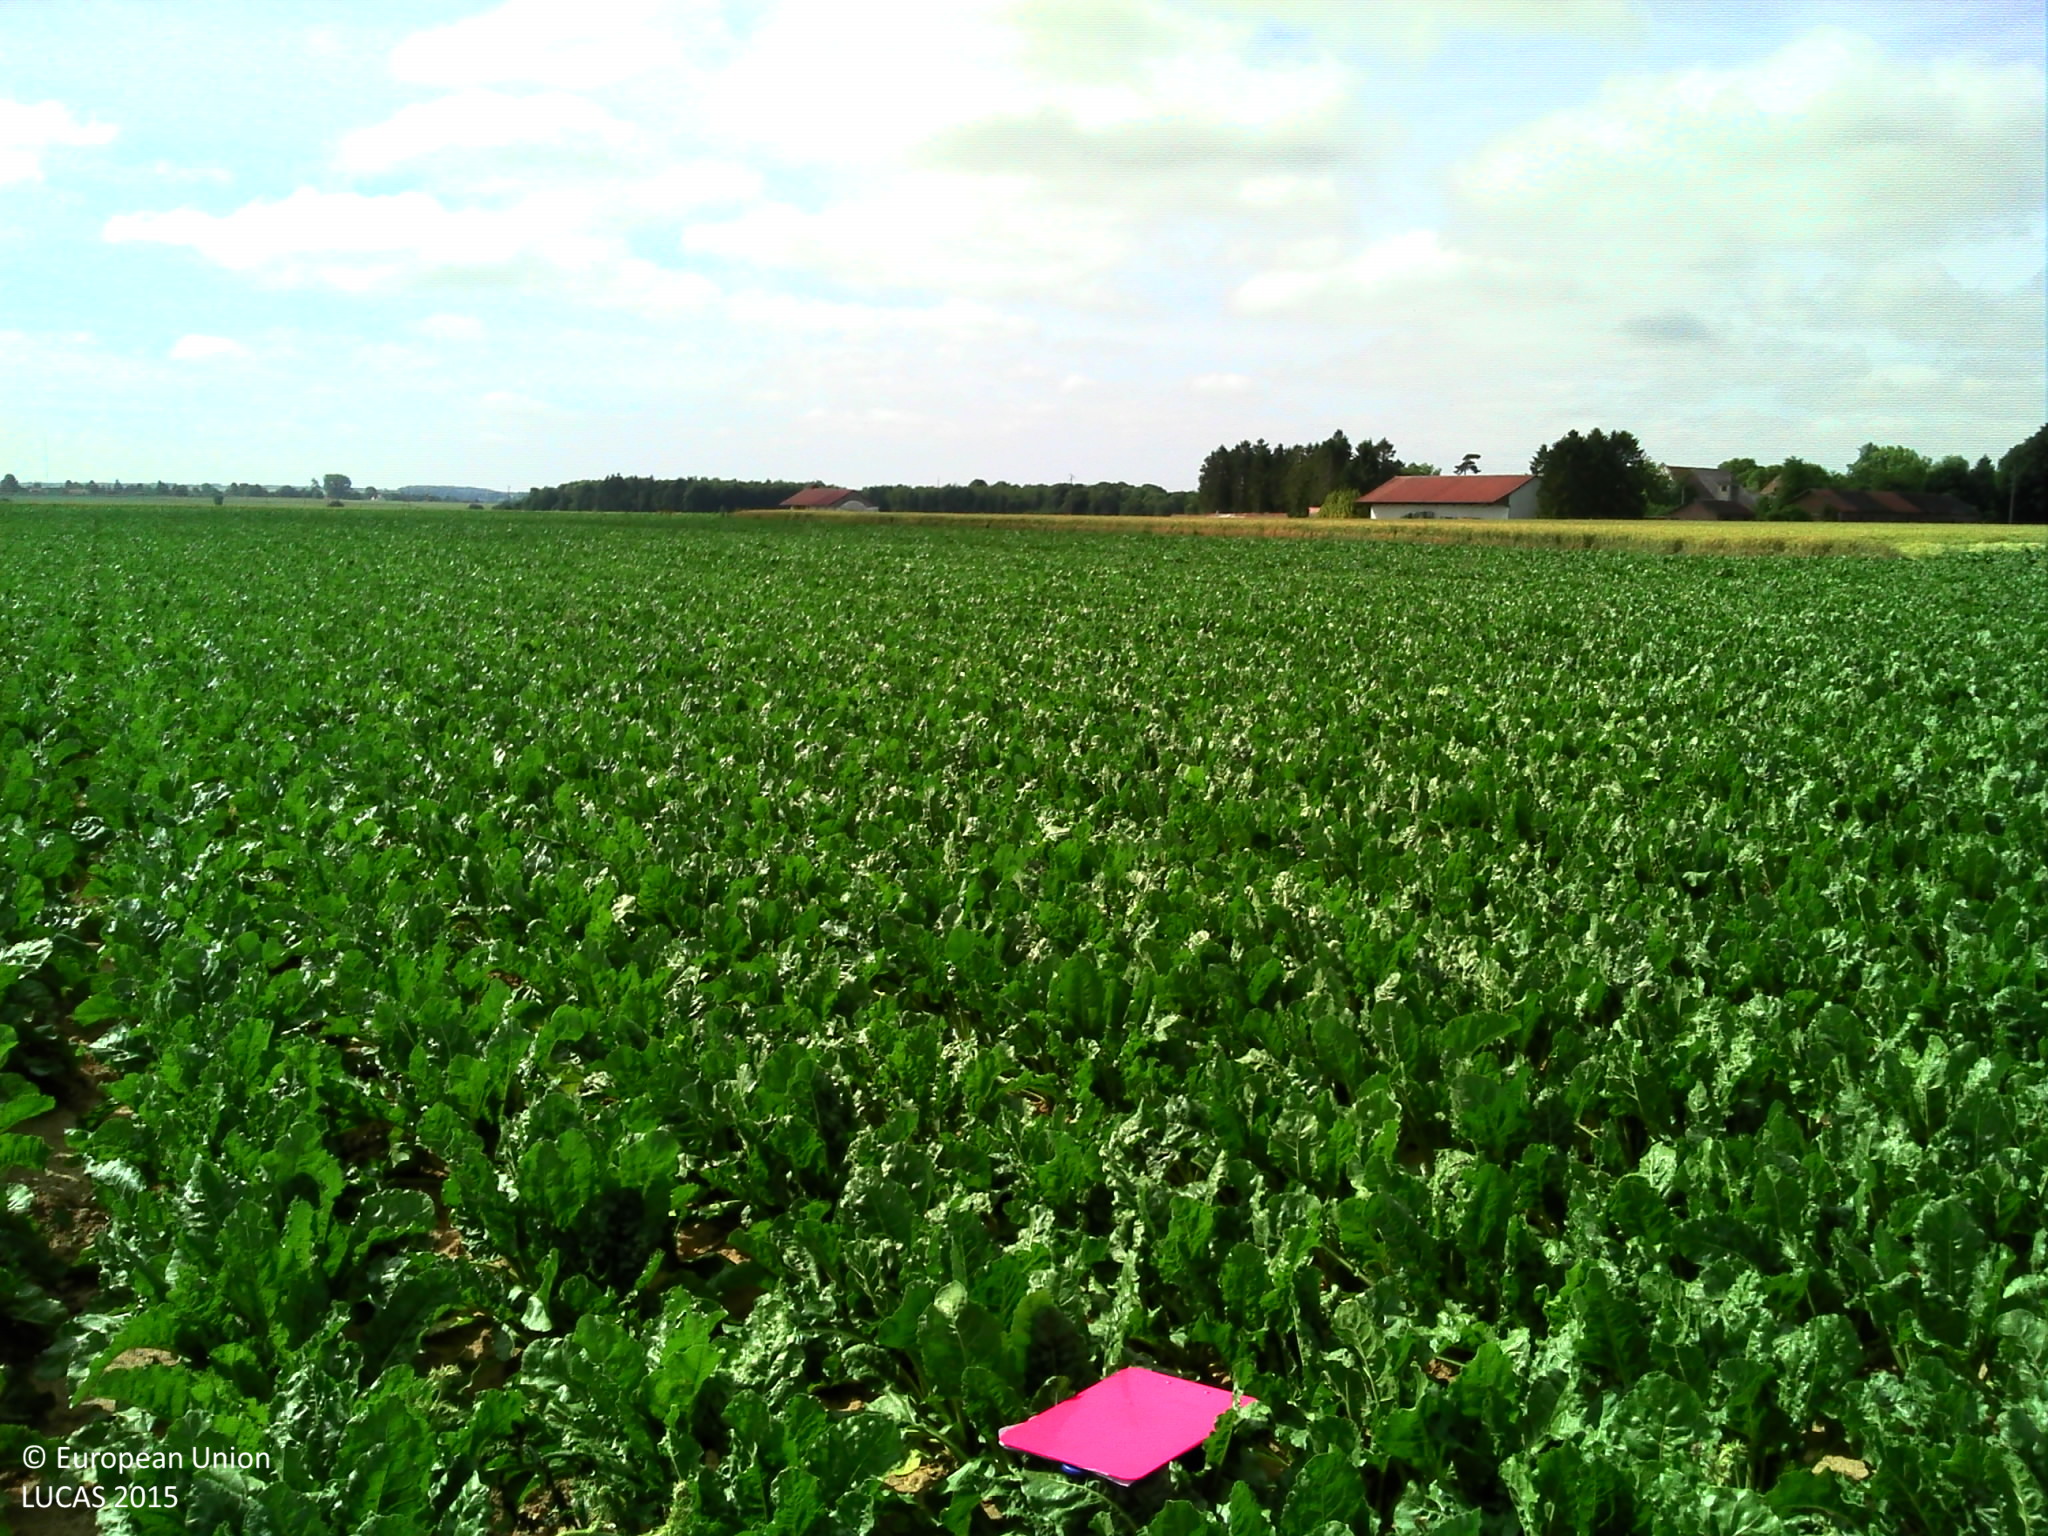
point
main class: Cropland
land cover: Sugar beet
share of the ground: > 75 %
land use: Agriculture (excluding fallow land and kitchen gardens)
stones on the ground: < 10 %
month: June
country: FR
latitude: 49.5651
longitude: 2.3410
